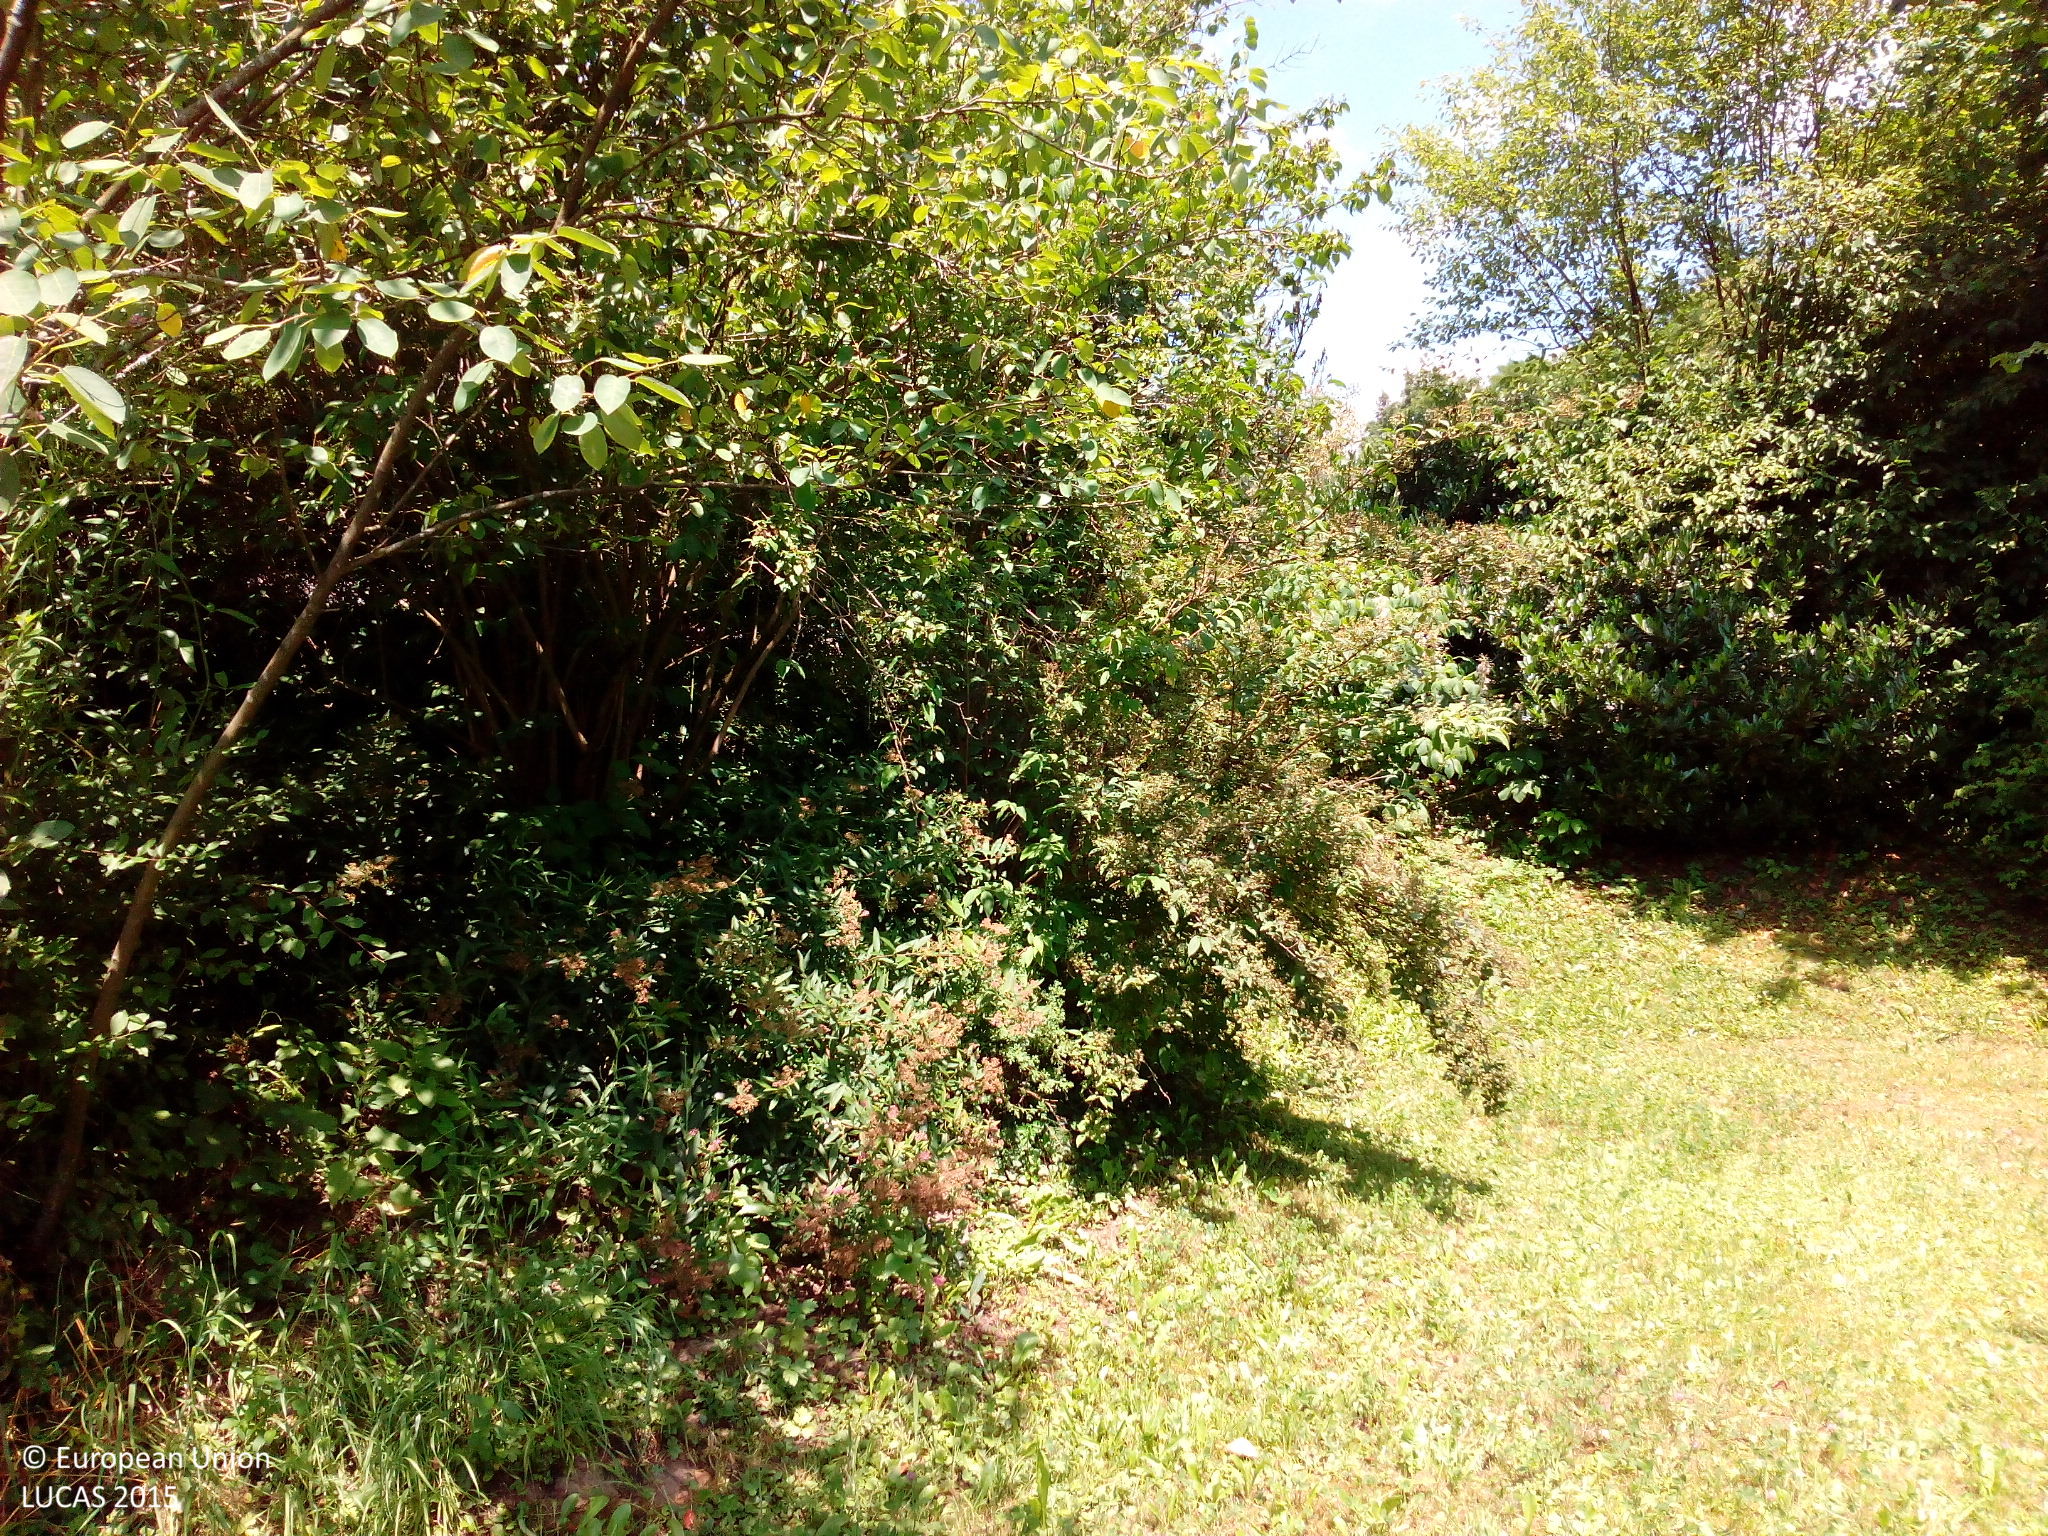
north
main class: Grassland
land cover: Grassland without tree/shrub cover
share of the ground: > 75 %
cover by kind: herbaceous plants 100 %
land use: Residential
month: July
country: DE
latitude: 48.9611
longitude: 9.8498
